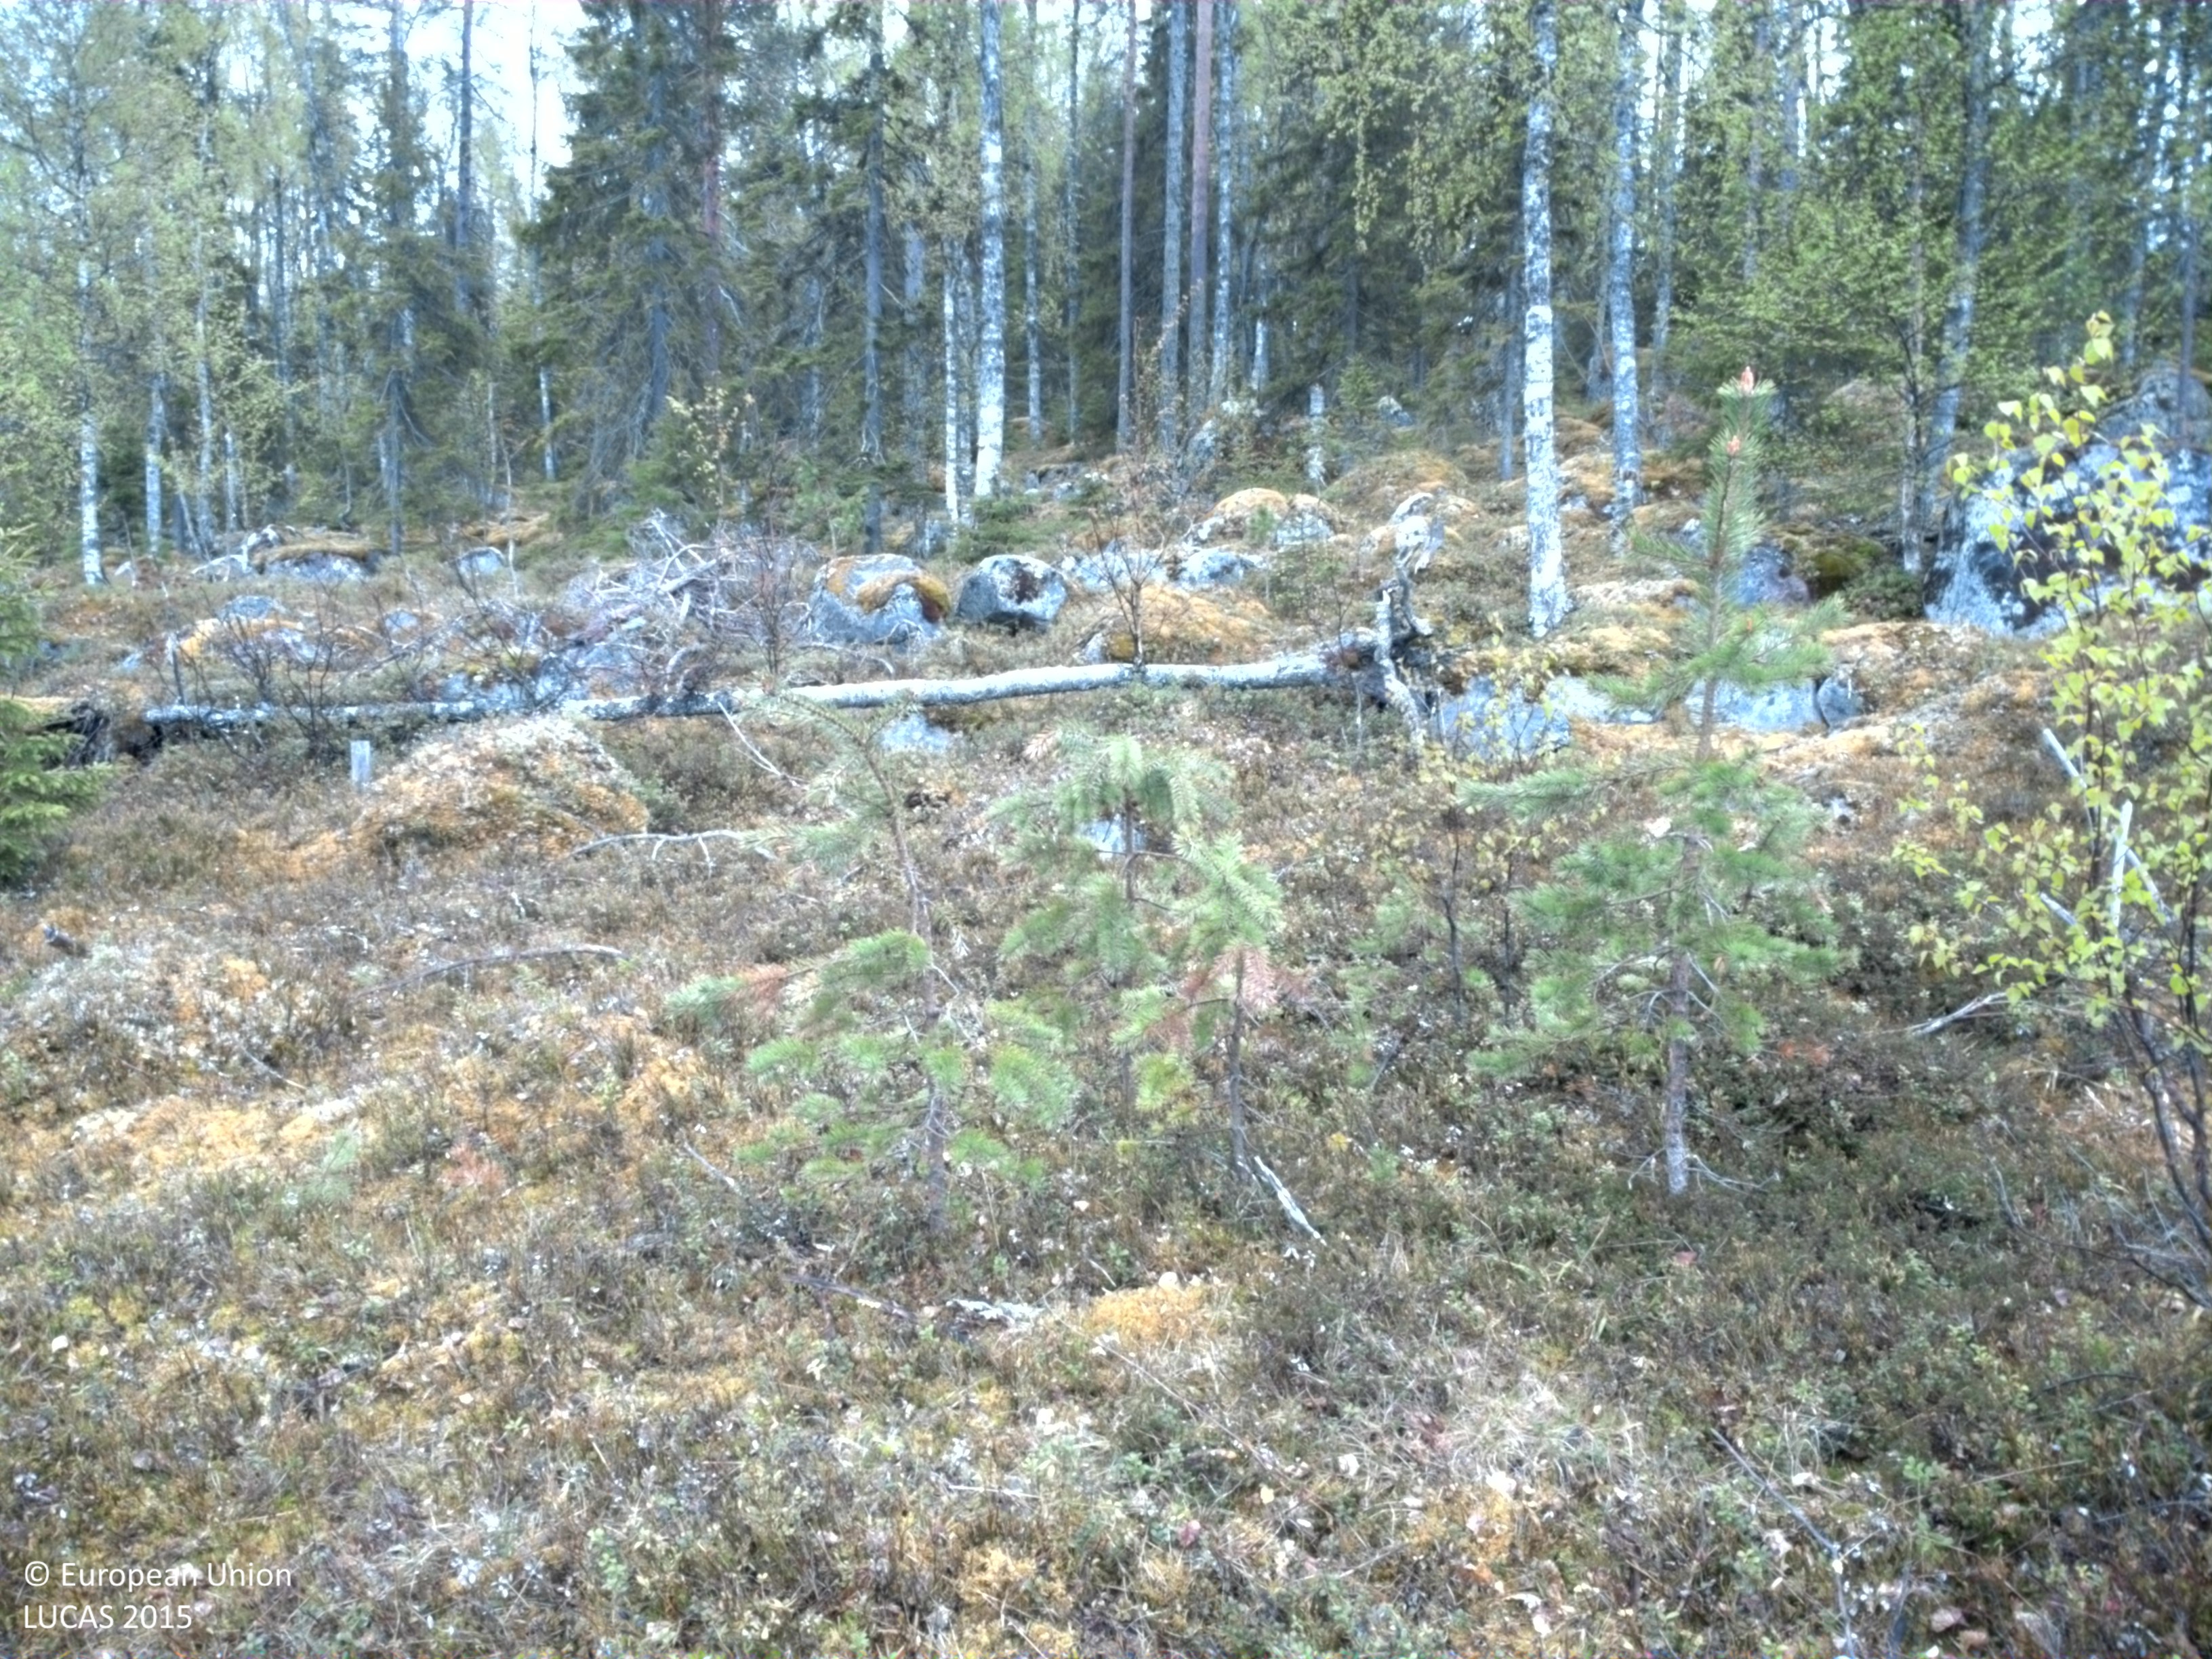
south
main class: Woodland
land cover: Pine dominated coniferous woodland
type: boreal forest
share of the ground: 25 - 50 %
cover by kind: shrubs 45 %, coniferous forest trees 40 %, broadleaved forest trees 5 %, herbaceous plants 5 %, lichens and mosses 5 %
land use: Forestry
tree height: < 5 m
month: June
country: SE
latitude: 65.9396
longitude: 23.1984
